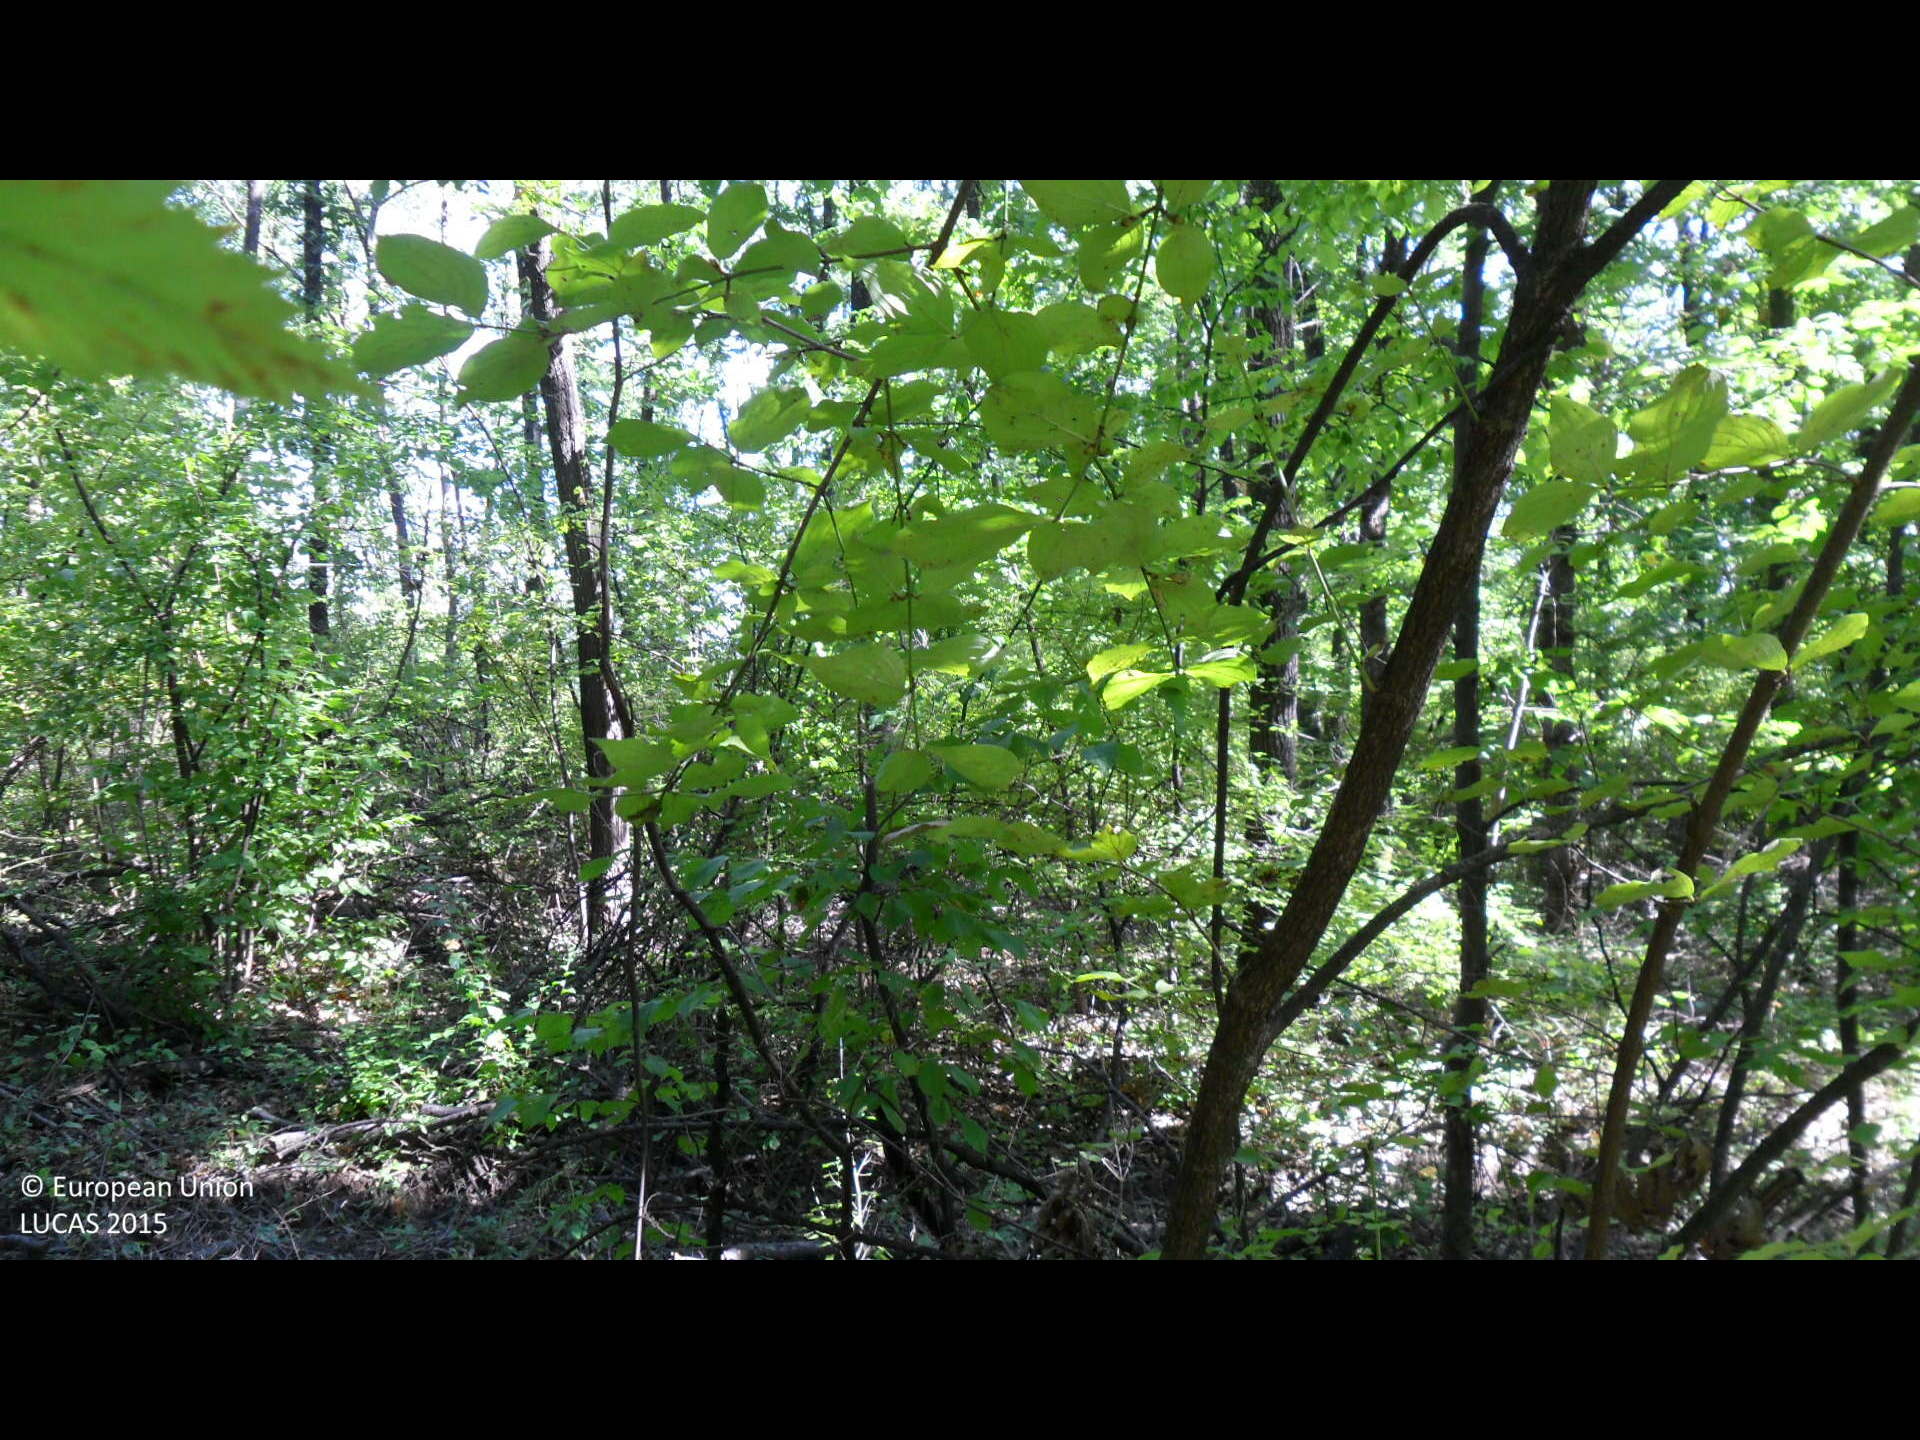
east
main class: Woodland
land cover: Broadleaved woodland
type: mesophytic deciduous forest
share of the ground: > 75 %
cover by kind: broadleaved forest trees 95 %, unconsolidated bare surface 5 %
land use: Forestry
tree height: > 5 m
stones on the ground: < 10 %
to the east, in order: Broadleaved woodland
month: October
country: BG
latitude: 43.1566
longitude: 26.2164
